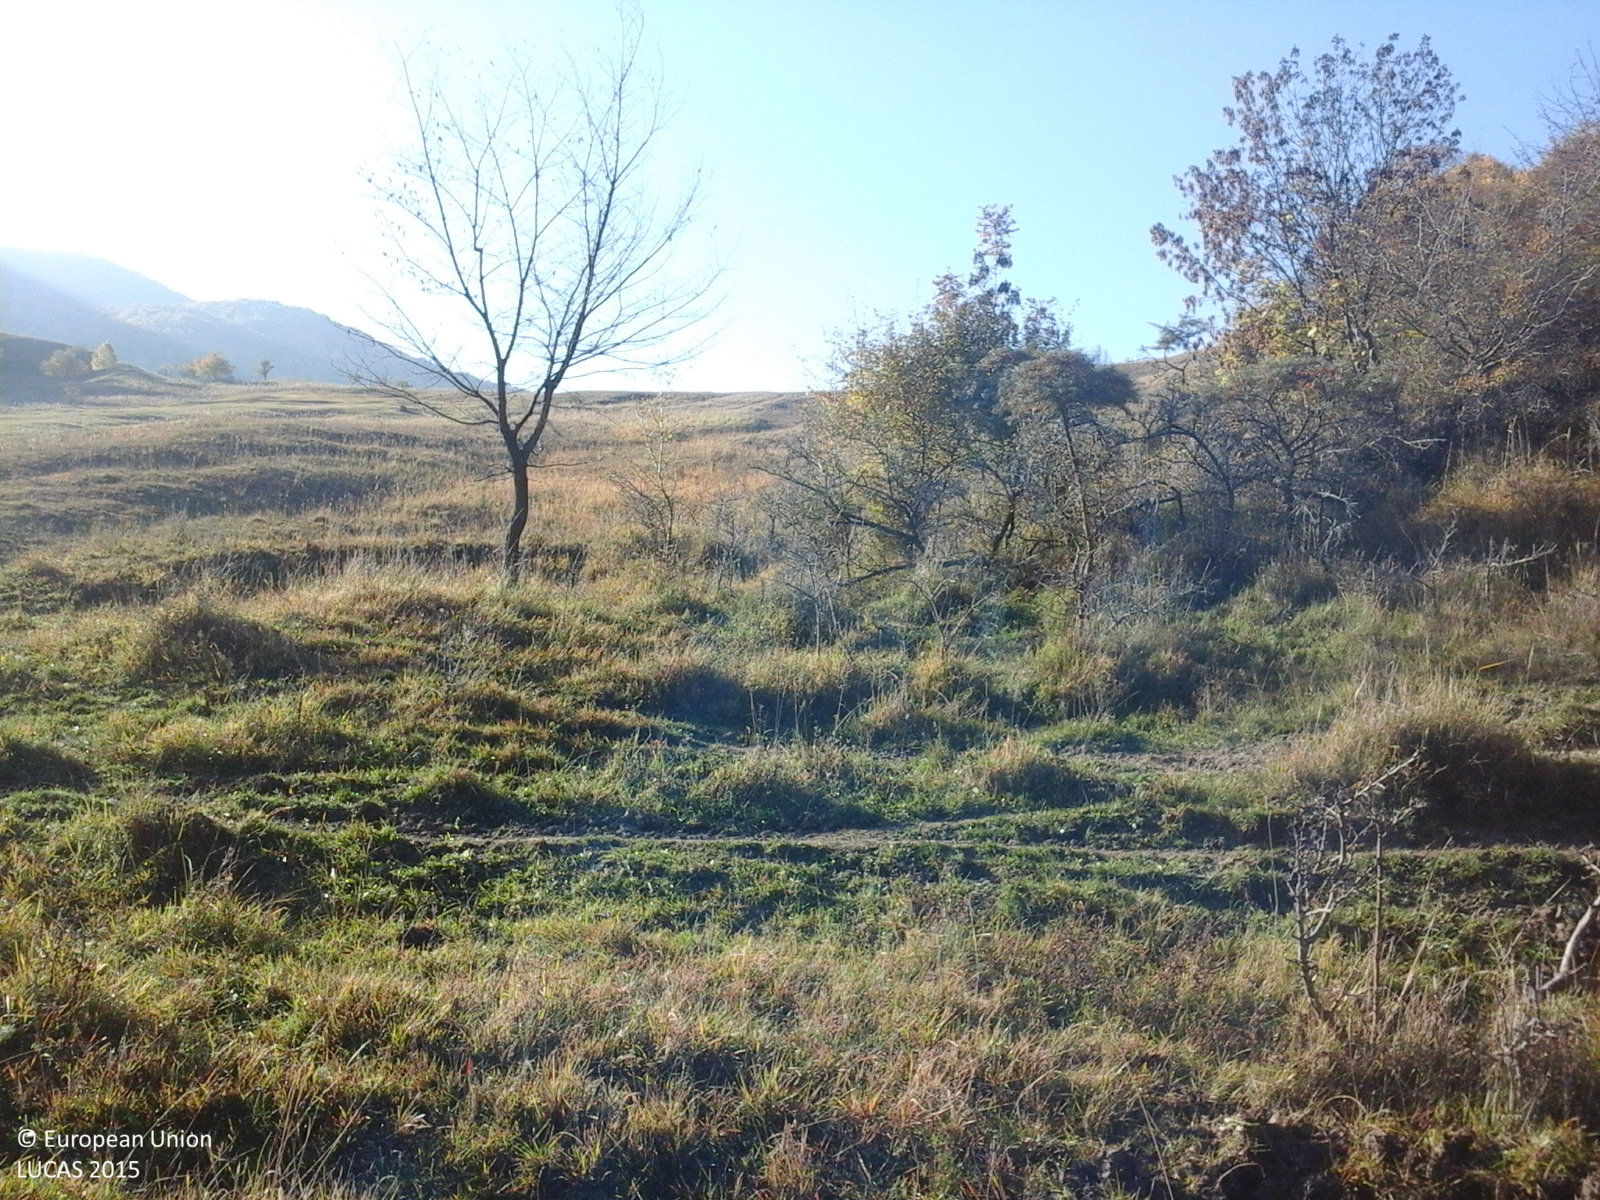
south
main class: Grassland
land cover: Grassland with sparse tree/shrub cover
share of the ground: > 75 %
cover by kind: herbaceous plants 85 %, shrubs 10 %, broadleaved forest trees 5 %
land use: Agriculture (excluding fallow land and kitchen gardens)
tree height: < 5 m
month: October
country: RO
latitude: 45.3618
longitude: 26.5561
